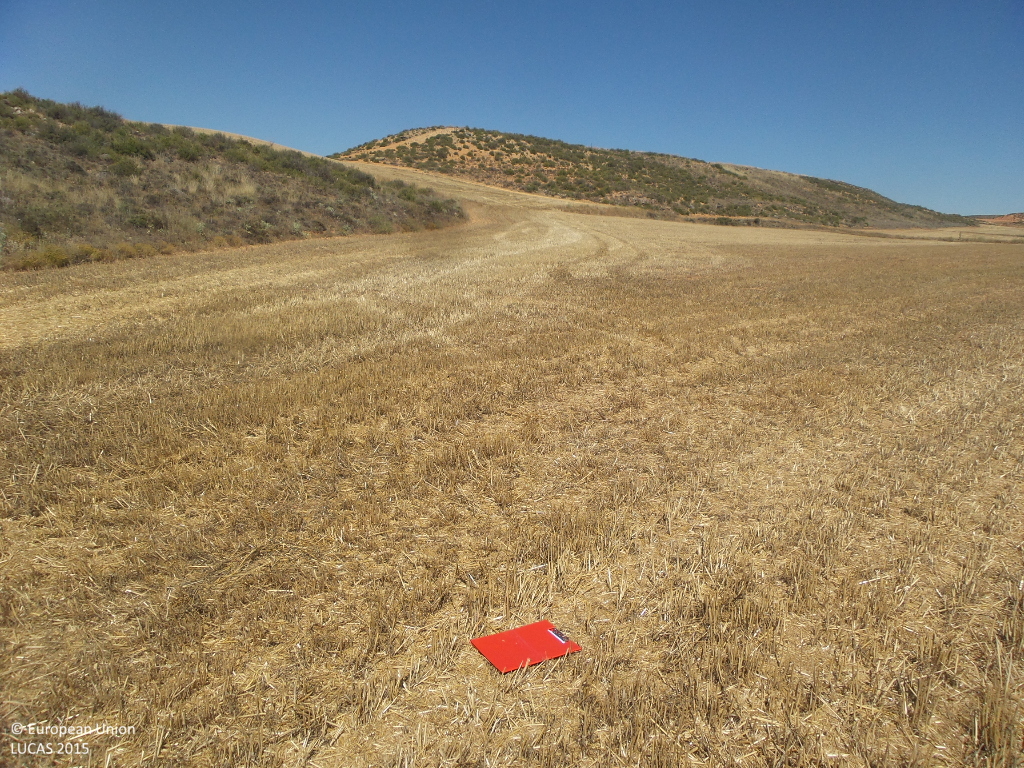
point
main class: Cropland
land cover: Common wheat
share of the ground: < 10 %
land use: Agriculture (excluding fallow land and kitchen gardens)
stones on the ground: < 10 %
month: July
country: ES
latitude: 41.3198
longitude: -2.1314
